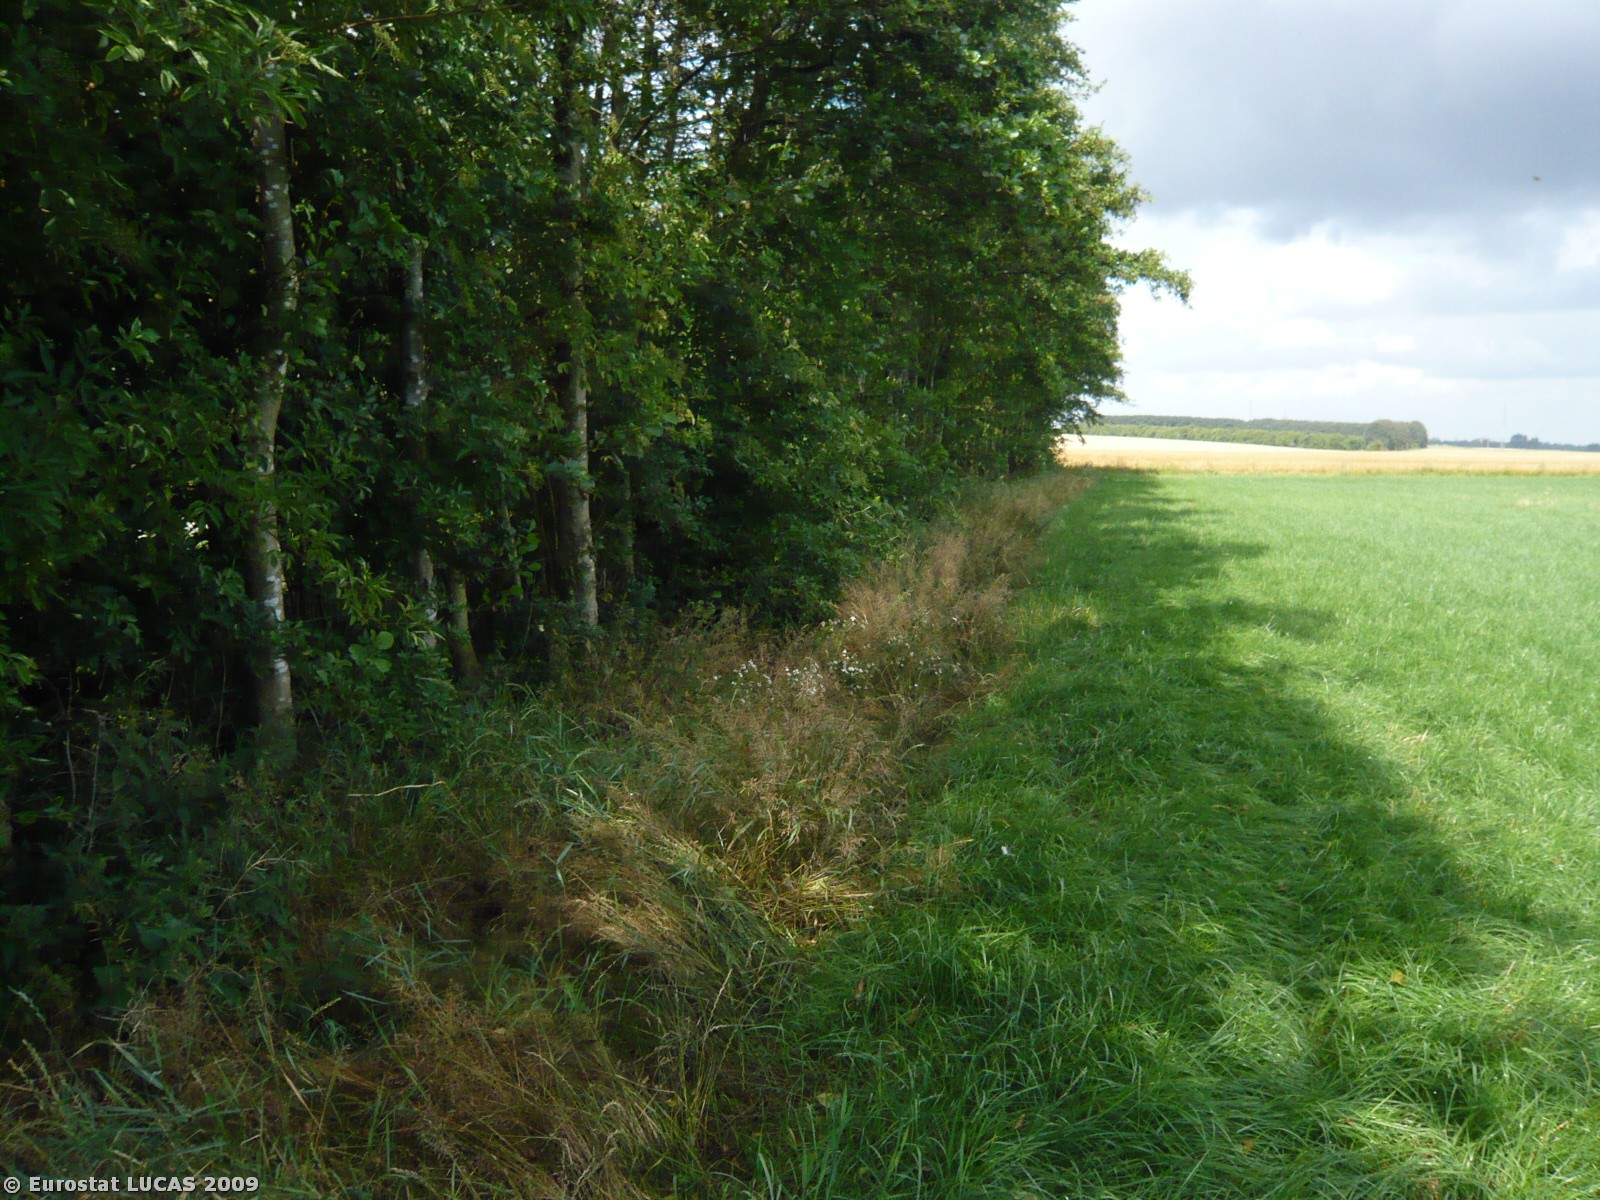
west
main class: Grassland
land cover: Grassland without tree/shrub cover
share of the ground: > 75 %
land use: Agriculture (excluding fallow land and kitchen gardens)
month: July
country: DK
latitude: 55.5956
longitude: 12.0771
